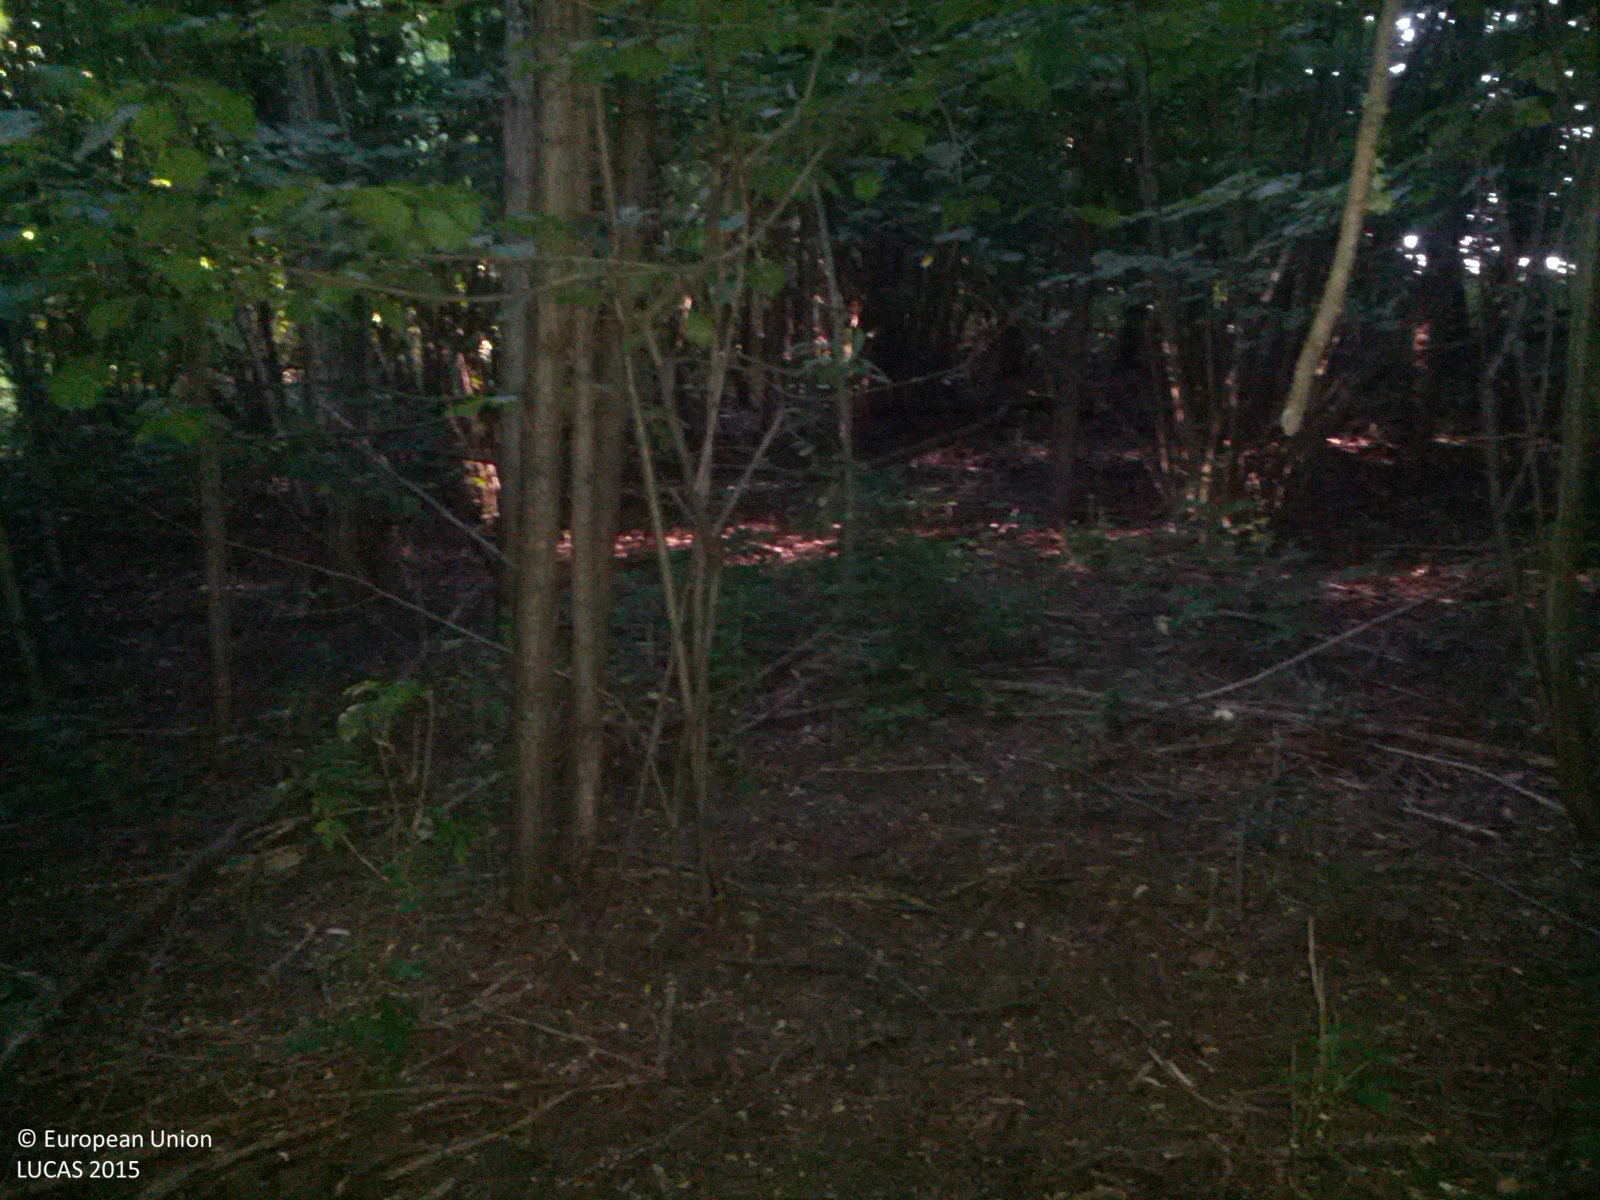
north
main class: Woodland
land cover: Broadleaved woodland
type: mesophytic deciduous forest
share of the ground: > 75 %
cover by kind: broadleaved forest trees 95 %, herbaceous plants 5 %
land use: Forestry
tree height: > 5 m
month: July
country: AT
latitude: 48.6402
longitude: 16.5886
